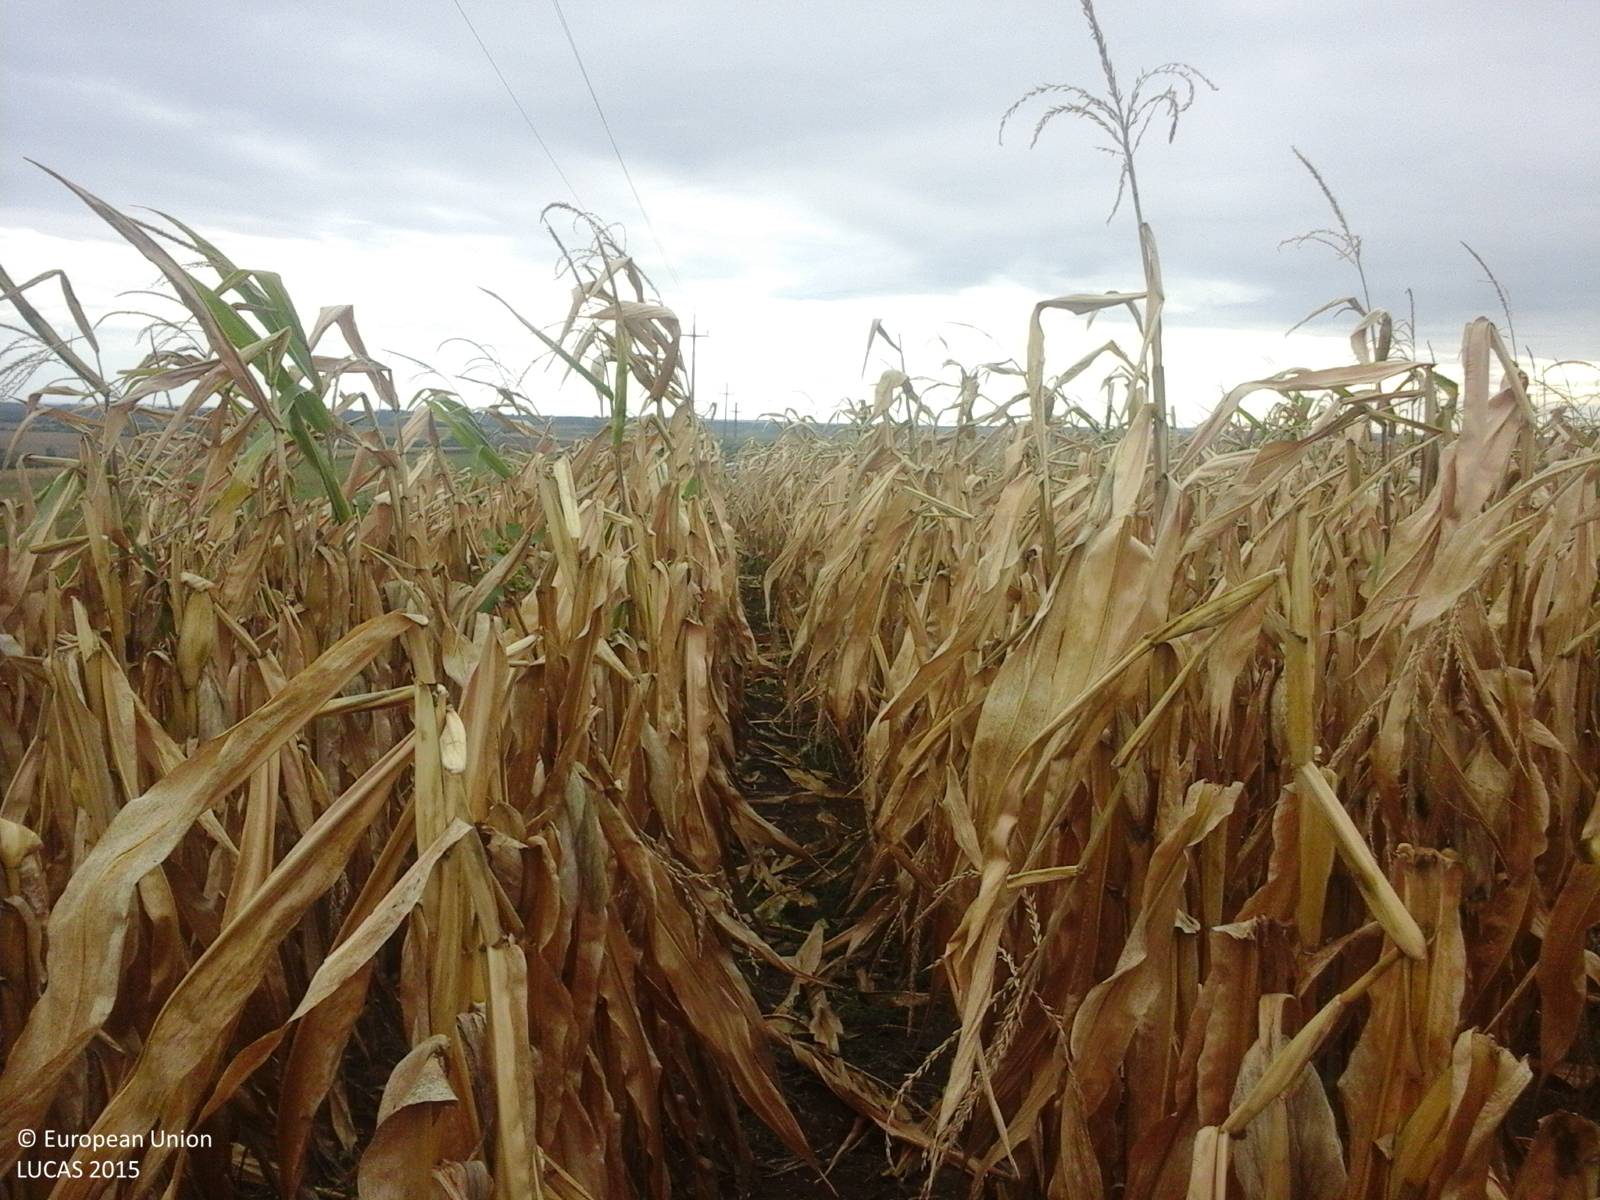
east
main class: Cropland
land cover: Maize
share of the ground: > 75 %
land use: Agriculture (excluding fallow land and kitchen gardens)
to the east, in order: Maize; Common wheat; Sunflower
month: September
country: RO
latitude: 47.4619
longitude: 22.4326
